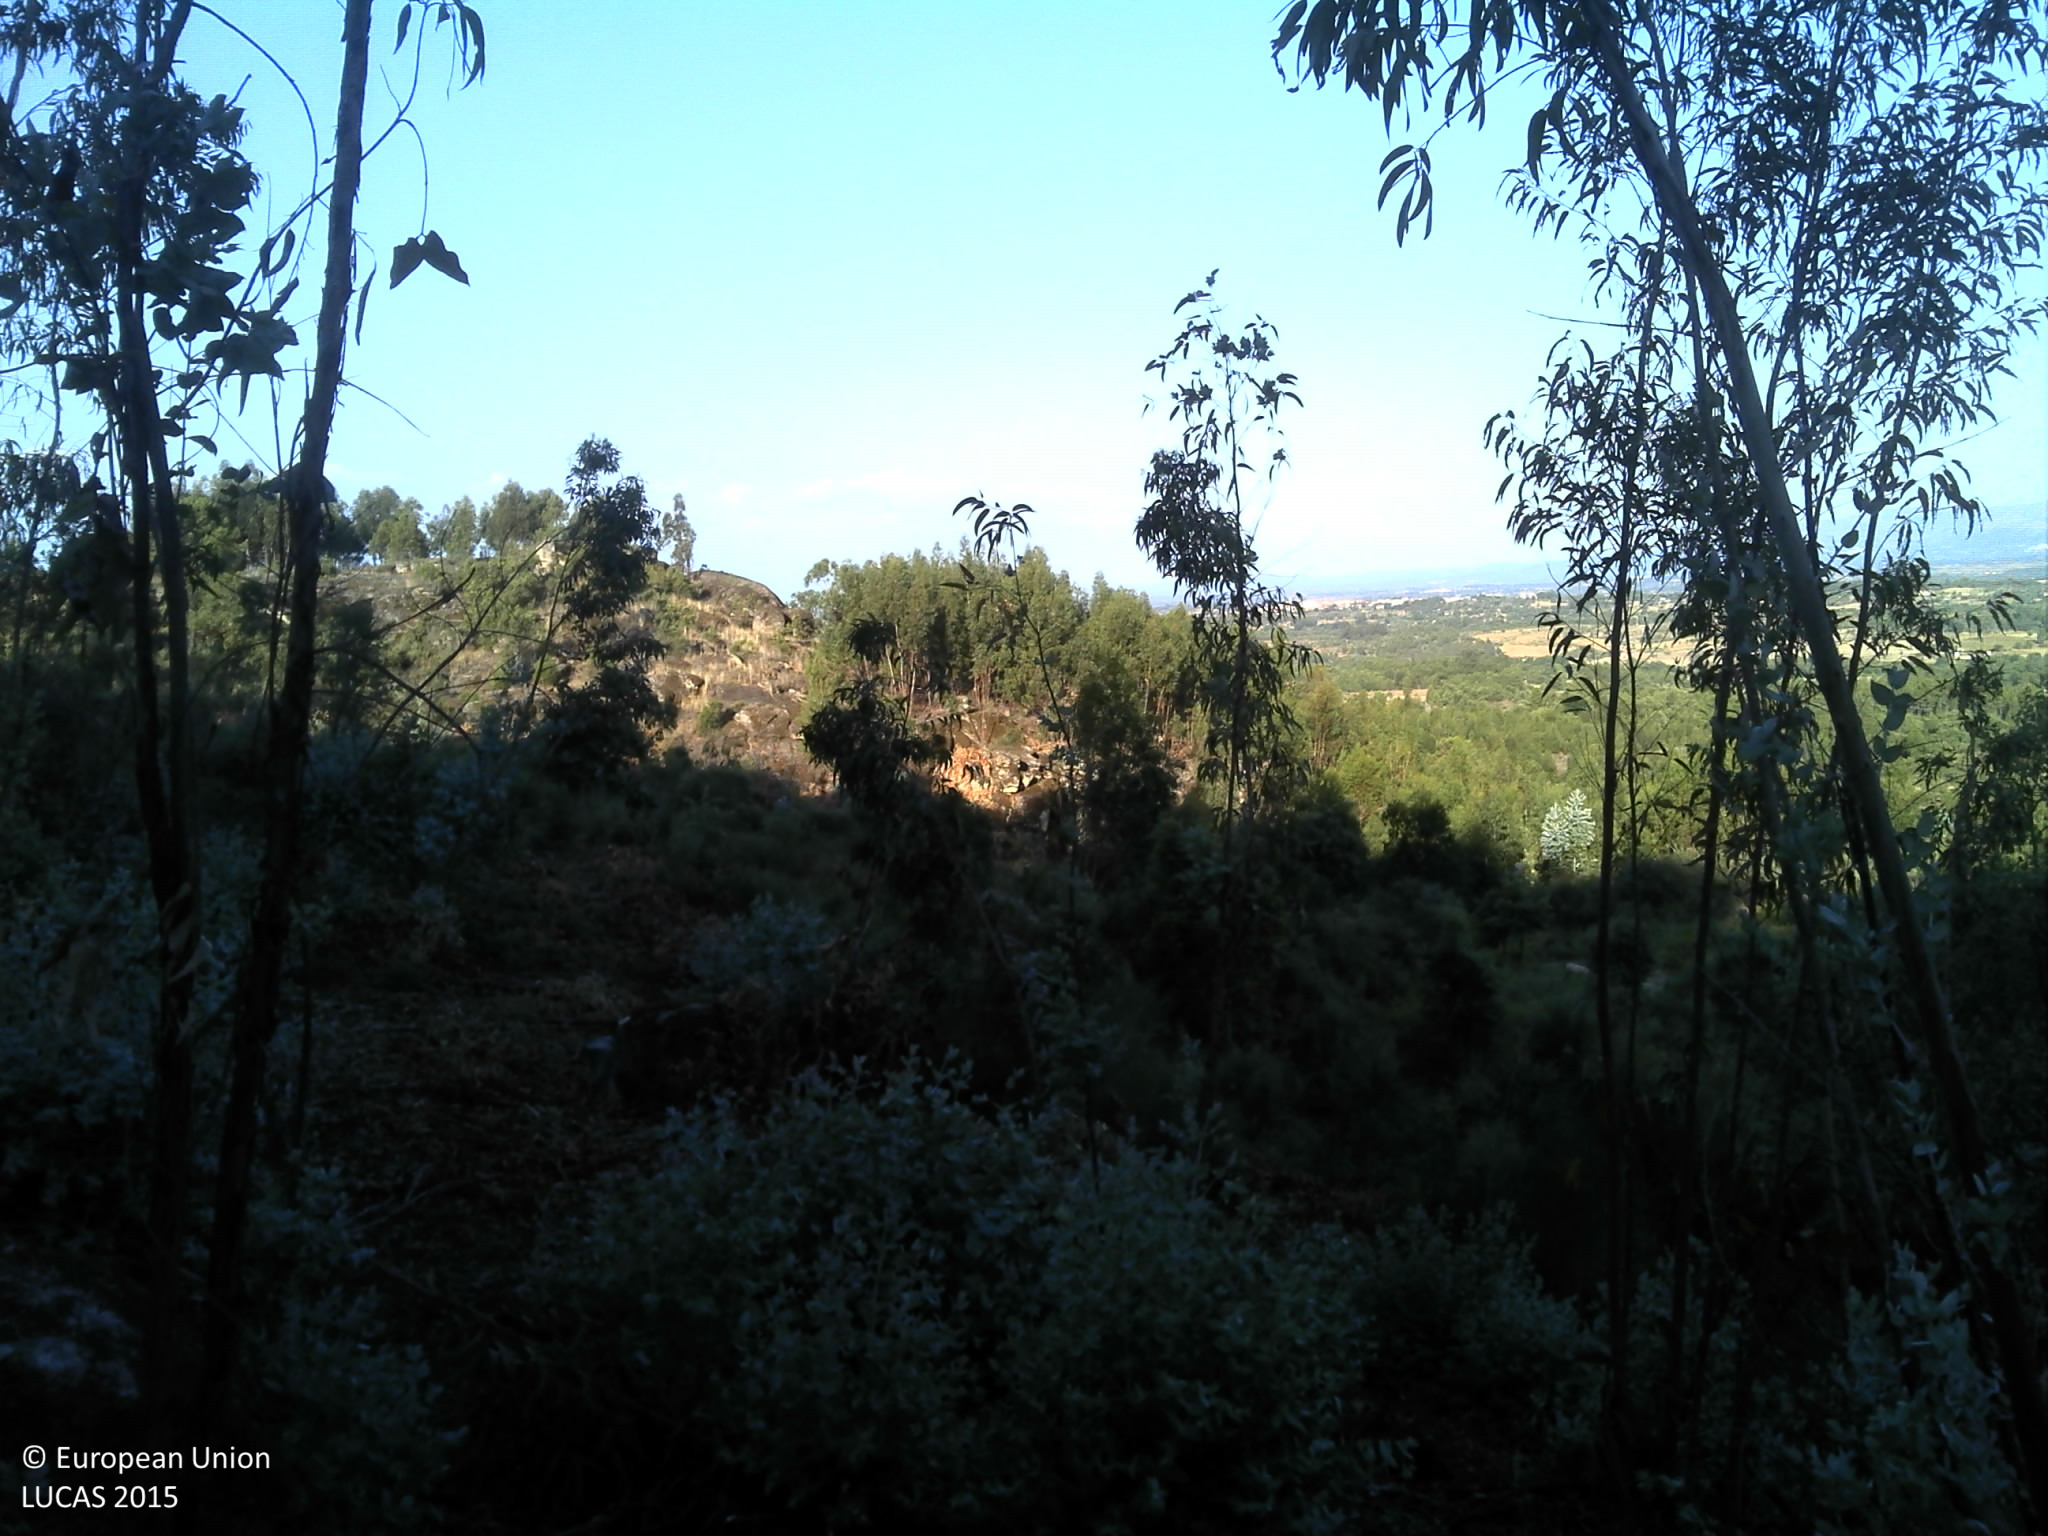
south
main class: Woodland
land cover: Broadleaved woodland
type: acidophilous oak and oak-birch forest
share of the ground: 25 - 50 %
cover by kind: broadleaved forest trees 45 %, consolidated bare surface 30 %, shrubs 15 %, unconsolidated bare surface 5 %
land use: Forestry
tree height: > 5 m
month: June
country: PT
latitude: 40.1025
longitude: -7.1884
